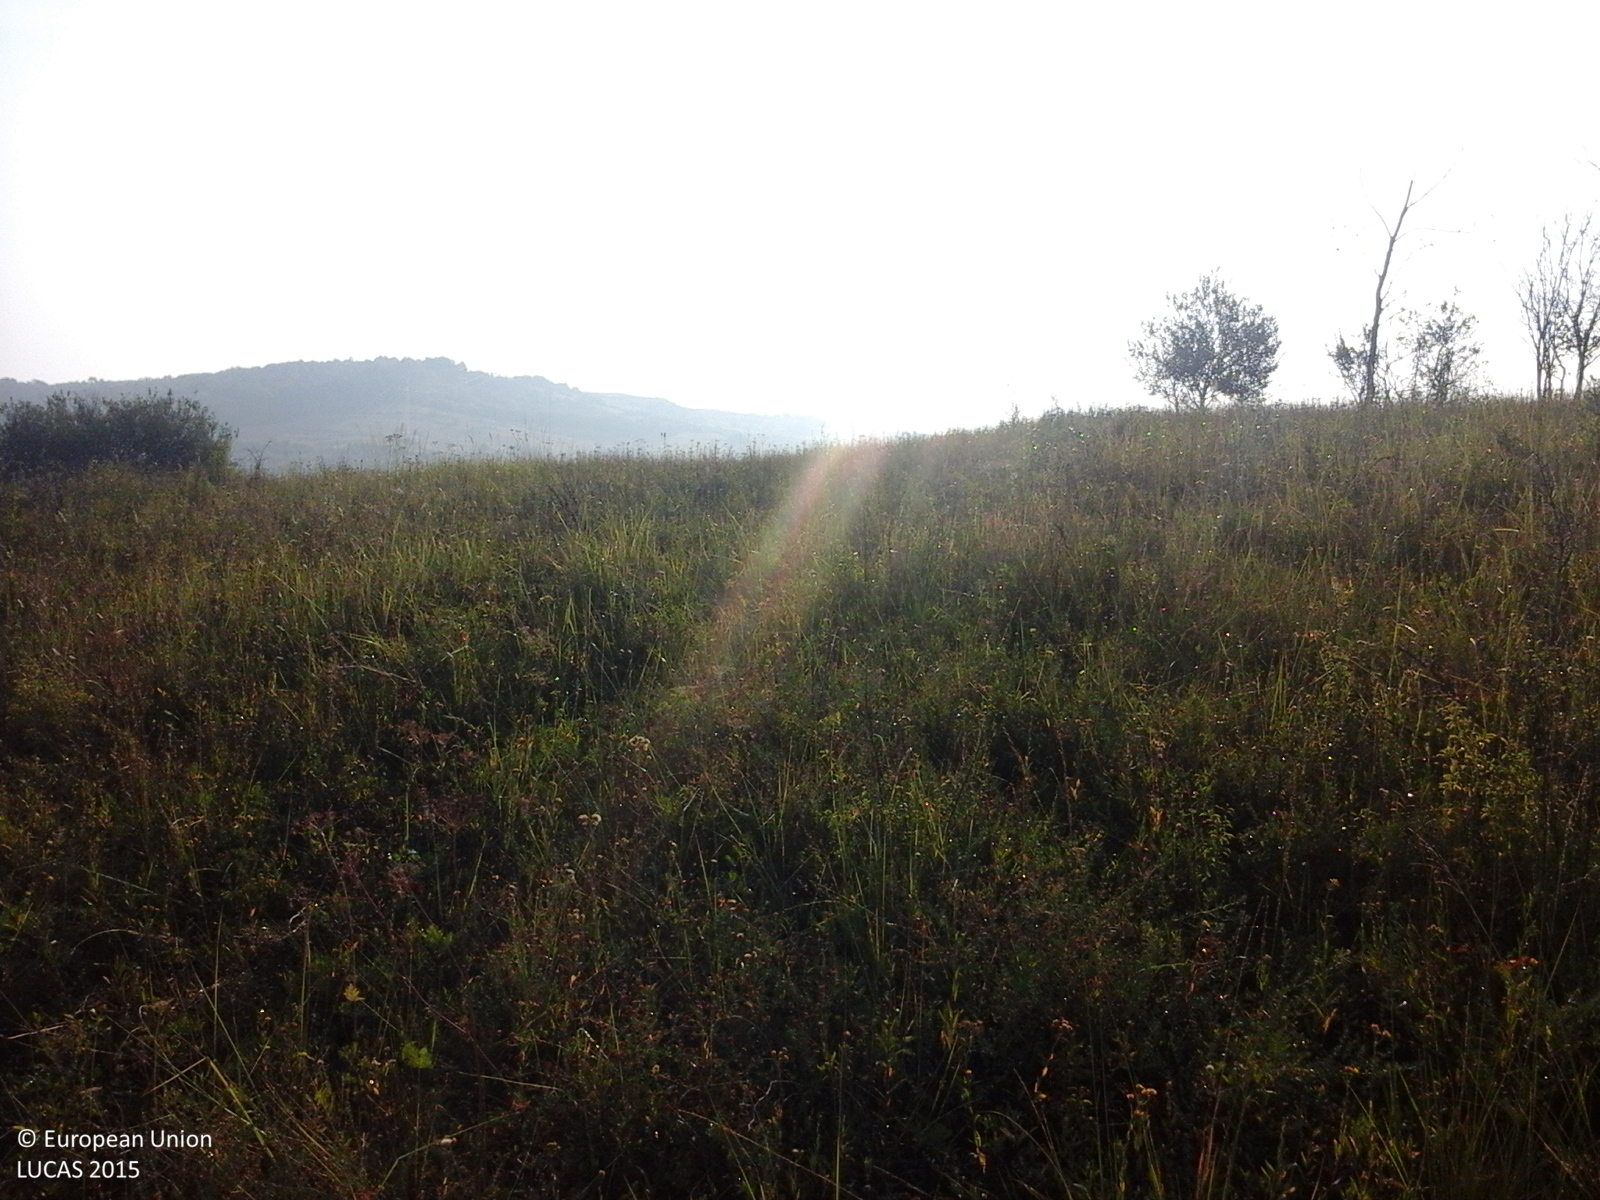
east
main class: Grassland
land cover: Grassland without tree/shrub cover
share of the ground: > 75 %
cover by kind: herbaceous plants 100 %
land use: Agriculture (excluding fallow land and kitchen gardens)
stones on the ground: < 10 %
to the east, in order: Grassland without tree/shrub cover; Tracks; Grassland without tree/shrub cover; Abandoned hedges; Grassland with sparse tree/shrub cover; Abandoned hedges; Grassland with sparse tree/shrub cover; Single bushes/trees; Grassland with sparse tree/shrub cover
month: September
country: RO
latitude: 47.2287
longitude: 24.3123
